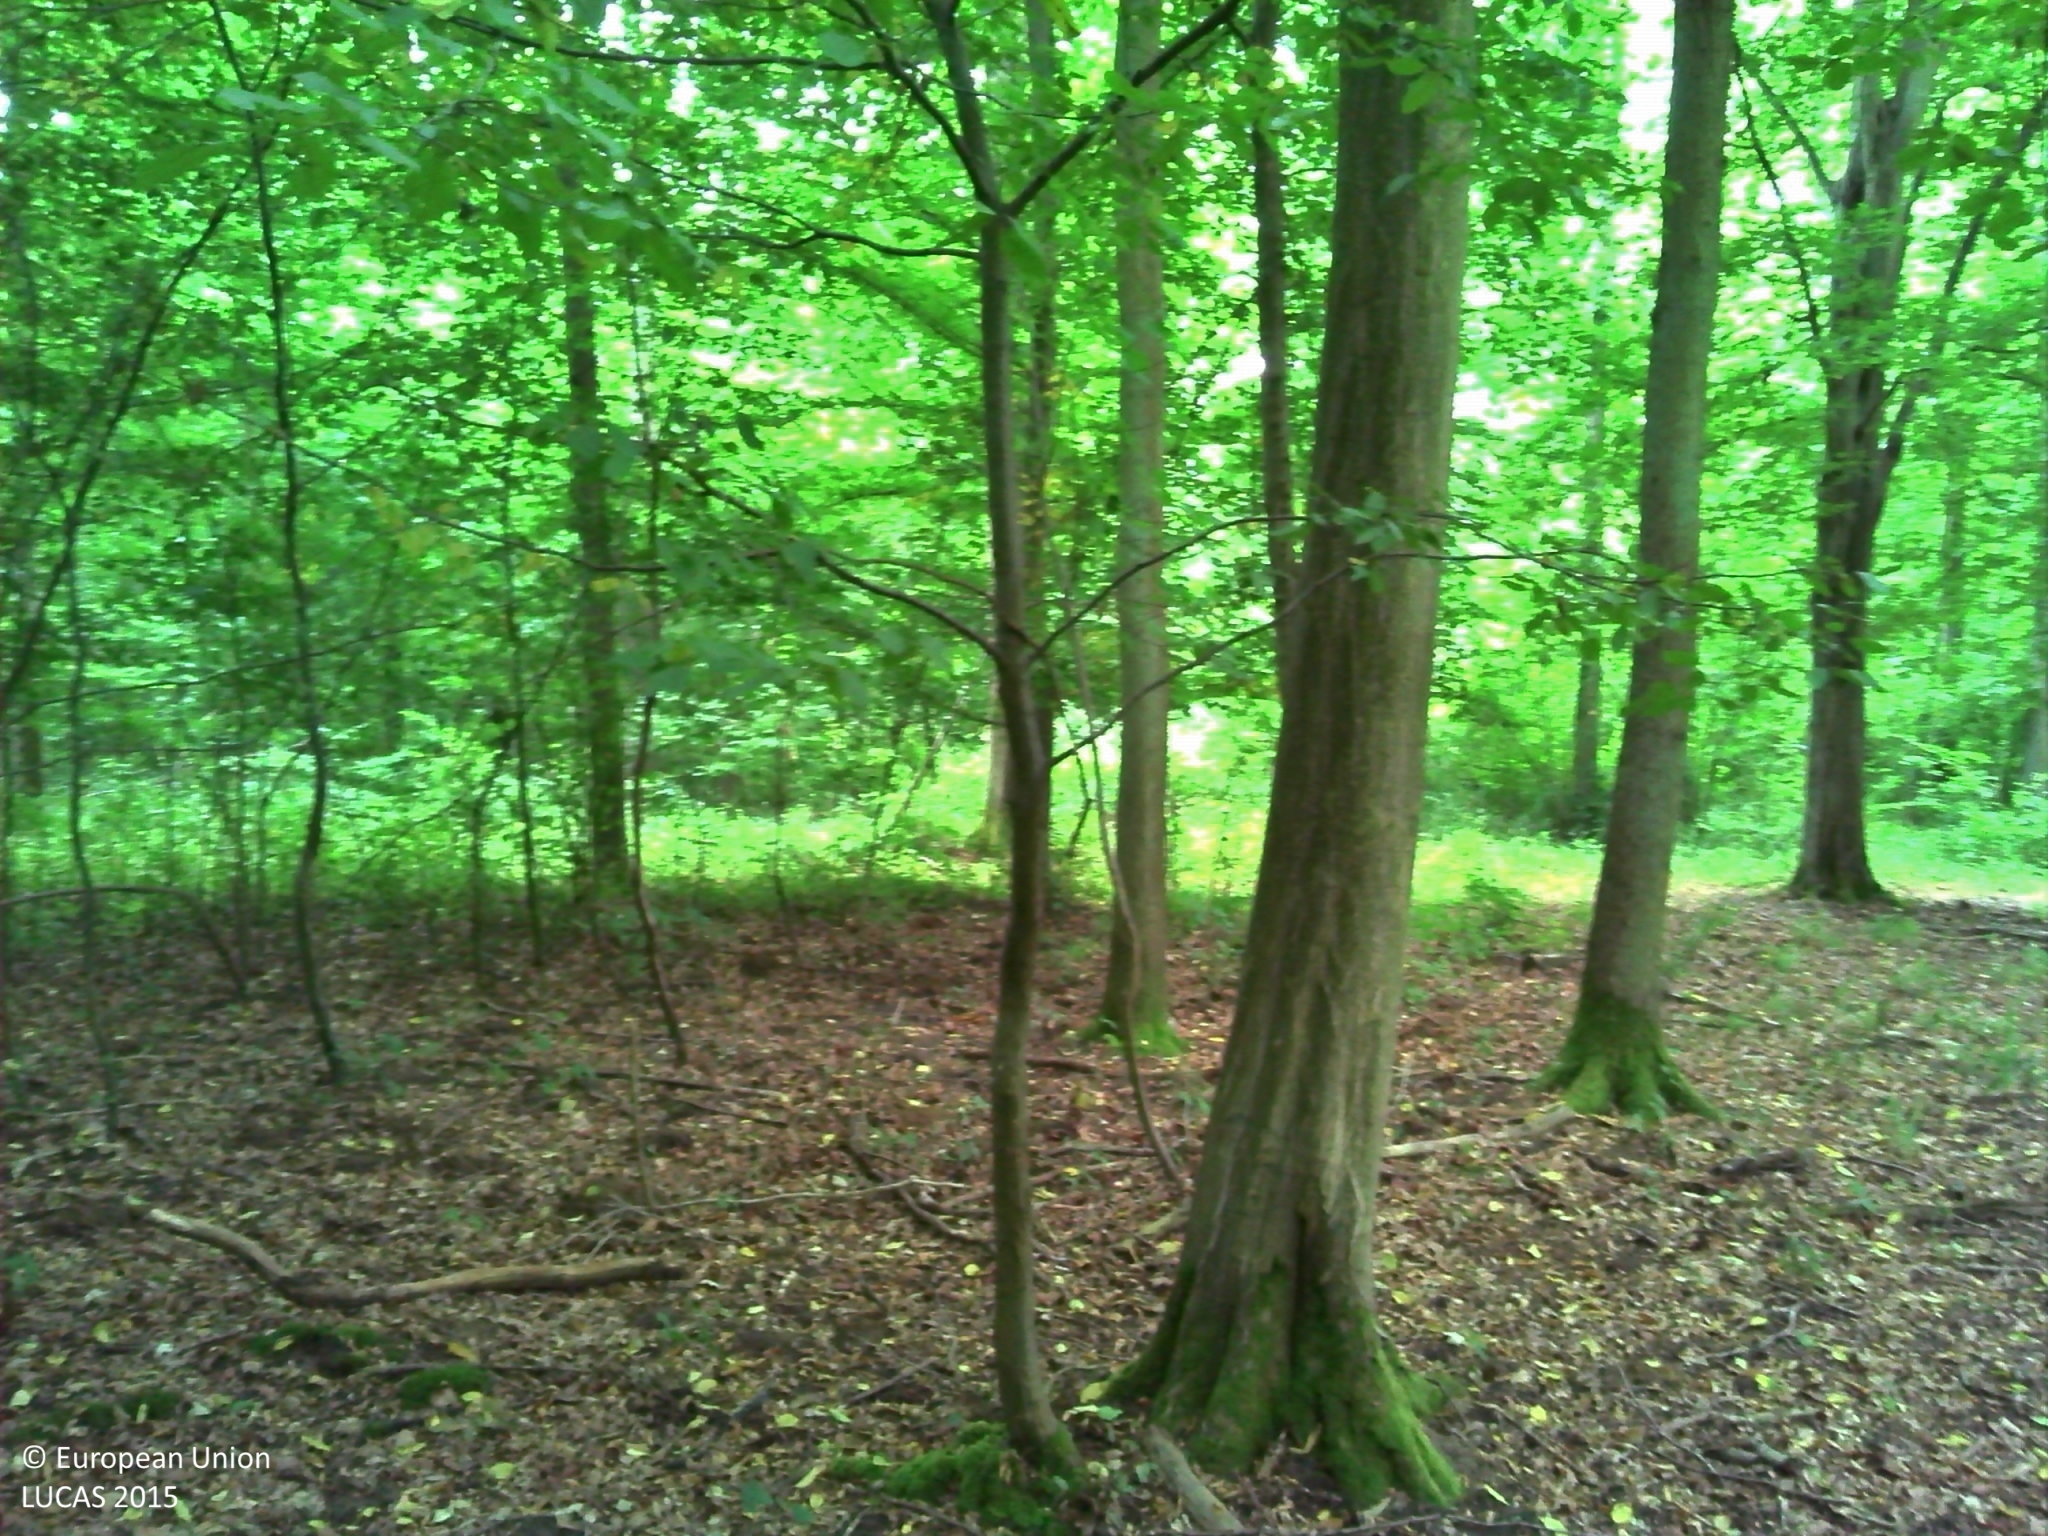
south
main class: Woodland
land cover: Broadleaved woodland
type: acidophilous oak and oak-birch forest
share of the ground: > 75 %
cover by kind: broadleaved forest trees 85 %, herbaceous plants 10 %, unconsolidated bare surface 5 %
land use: Forestry
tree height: > 5 m
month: July
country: FR
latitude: 49.1847
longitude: 2.5939
